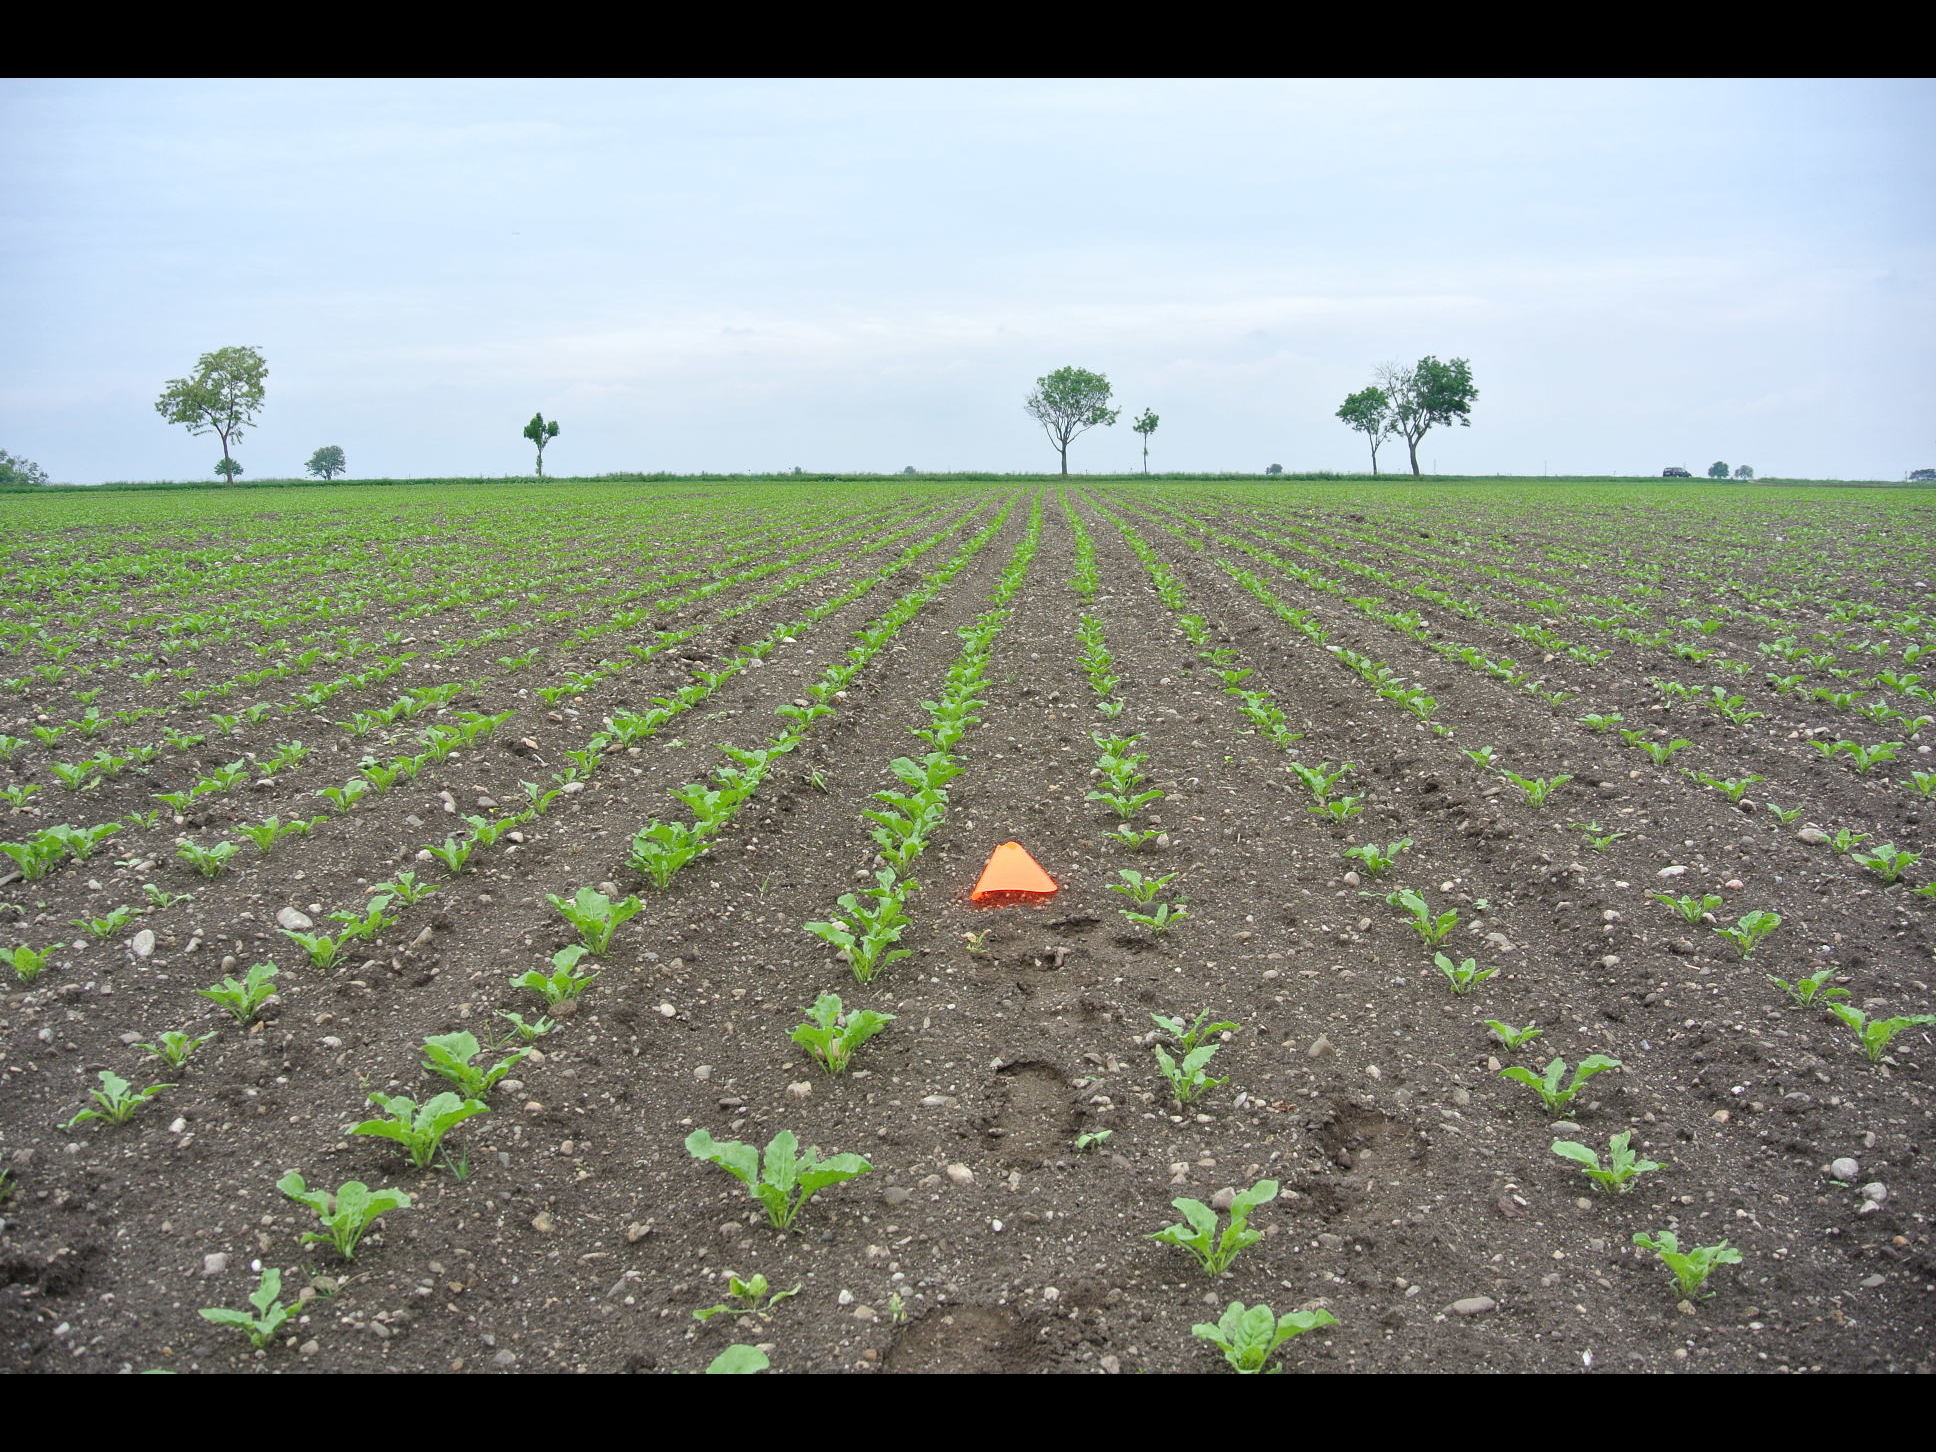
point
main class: Cropland
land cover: Sugar beet
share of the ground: 10 - 25 %
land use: Agriculture (excluding fallow land and kitchen gardens)
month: May
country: AT
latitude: 48.0522
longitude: 16.4581
